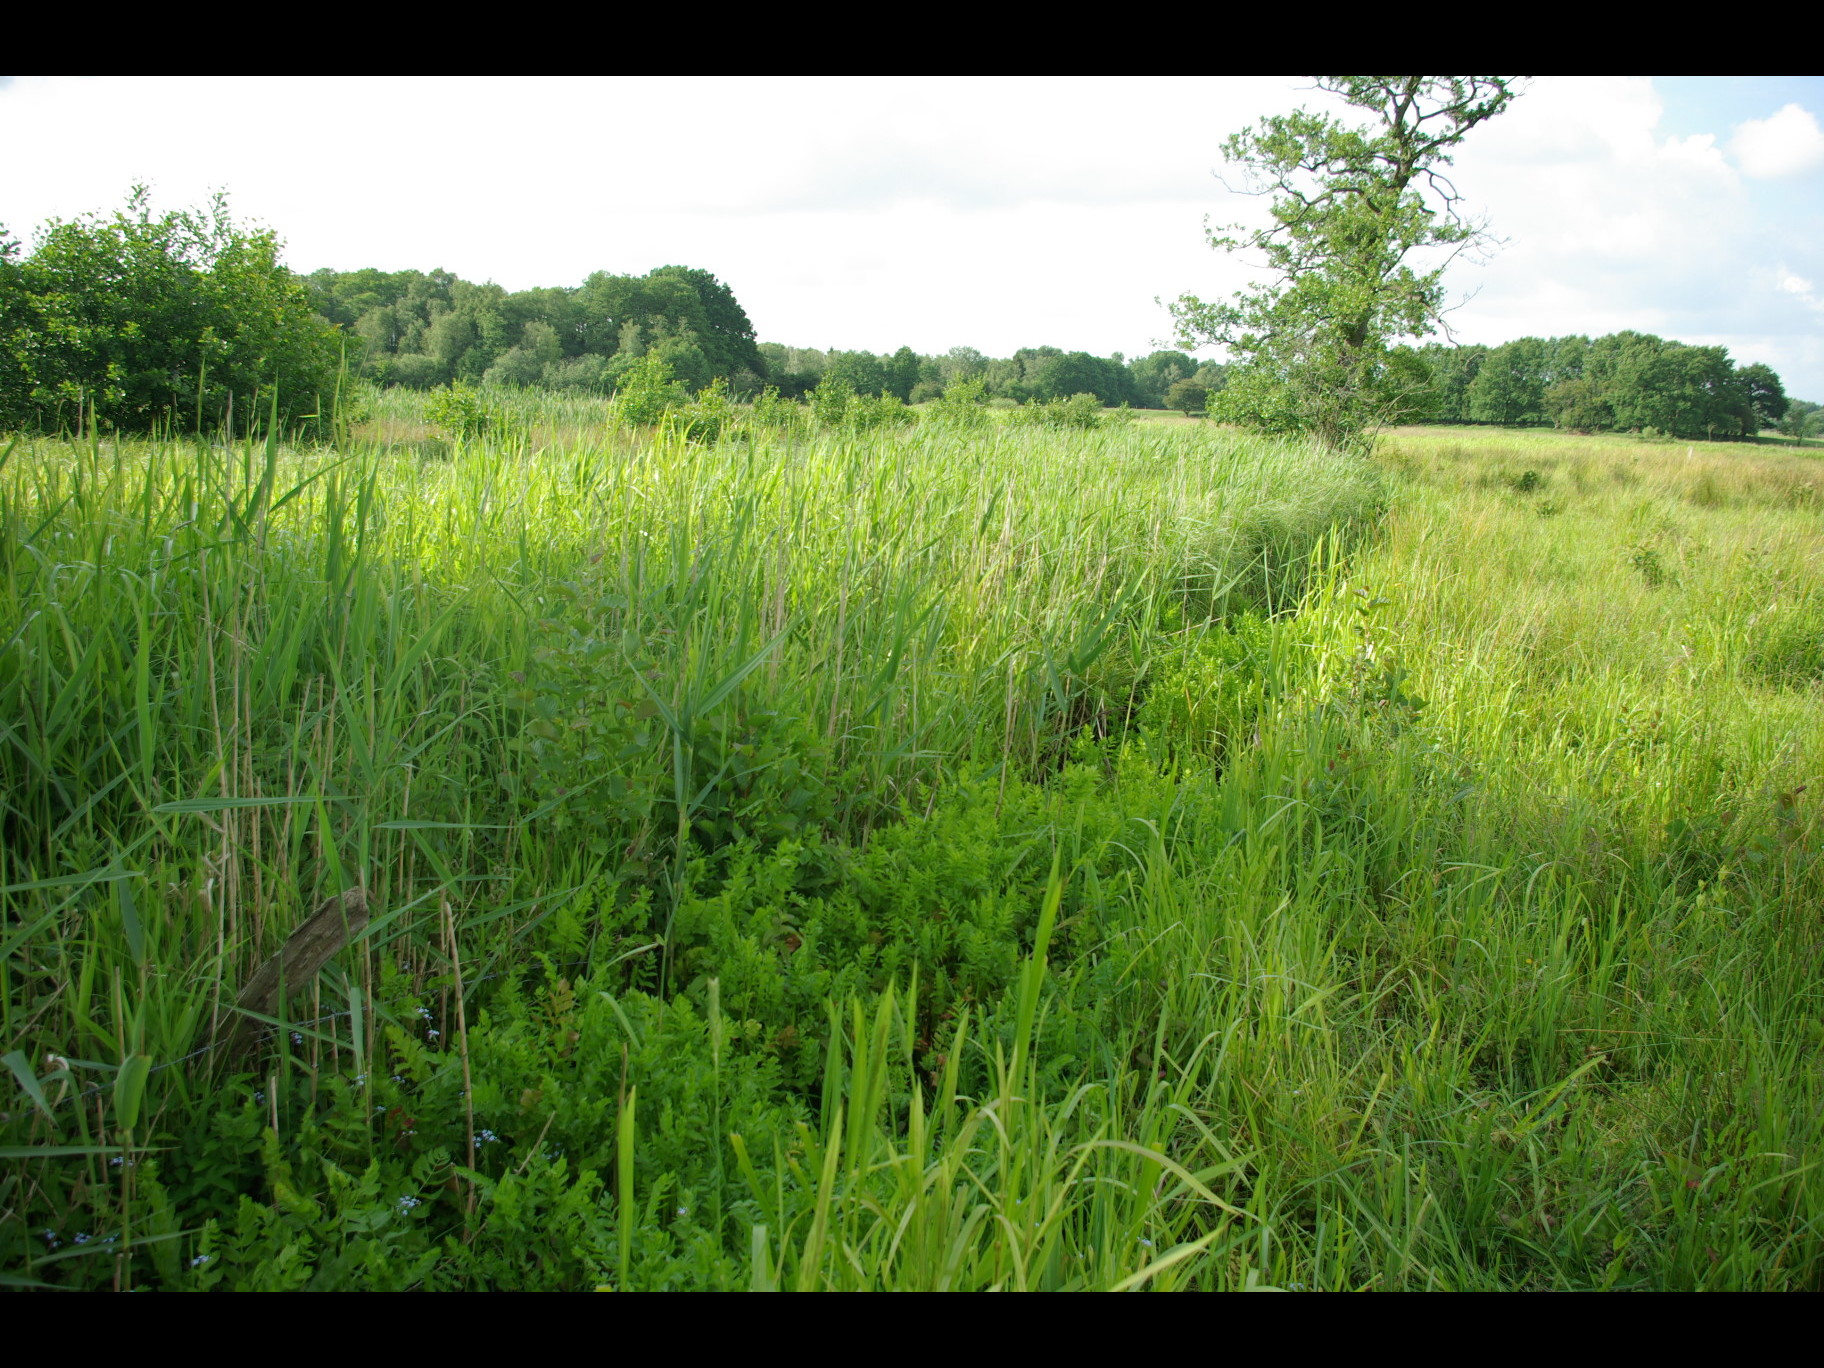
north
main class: Woodland
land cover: Broadleaved woodland
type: mire and swamp forests
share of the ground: > 75 %
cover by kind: broadleaved forest trees 60 %, herbaceous plants 30 %, shrubs 10 %
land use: Semi-natural and natural areas not in use
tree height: > 5 m
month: June
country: DE
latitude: 54.1927
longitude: 9.9234
